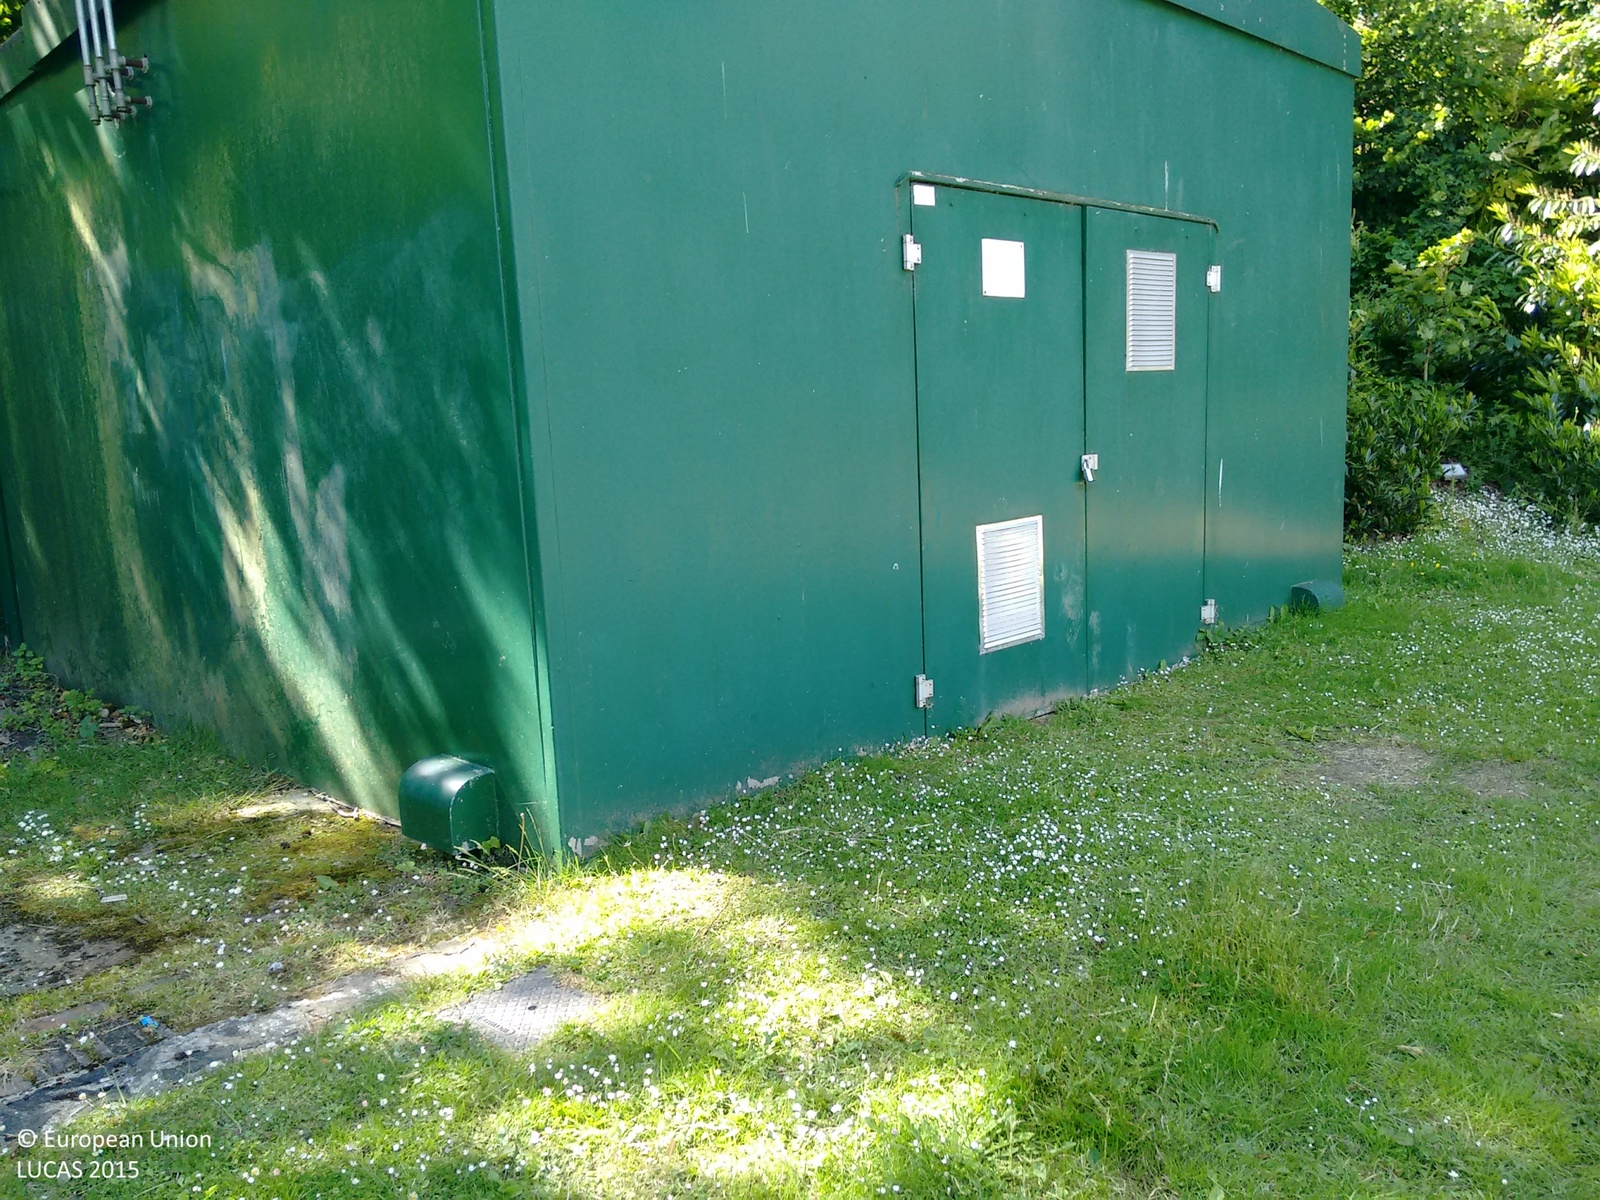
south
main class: Grassland
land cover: Grassland without tree/shrub cover
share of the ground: > 75 %
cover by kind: herbaceous plants 100 %
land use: Amenities, museums, leisure
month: June
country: GB
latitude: 50.8618
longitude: 0.5819
